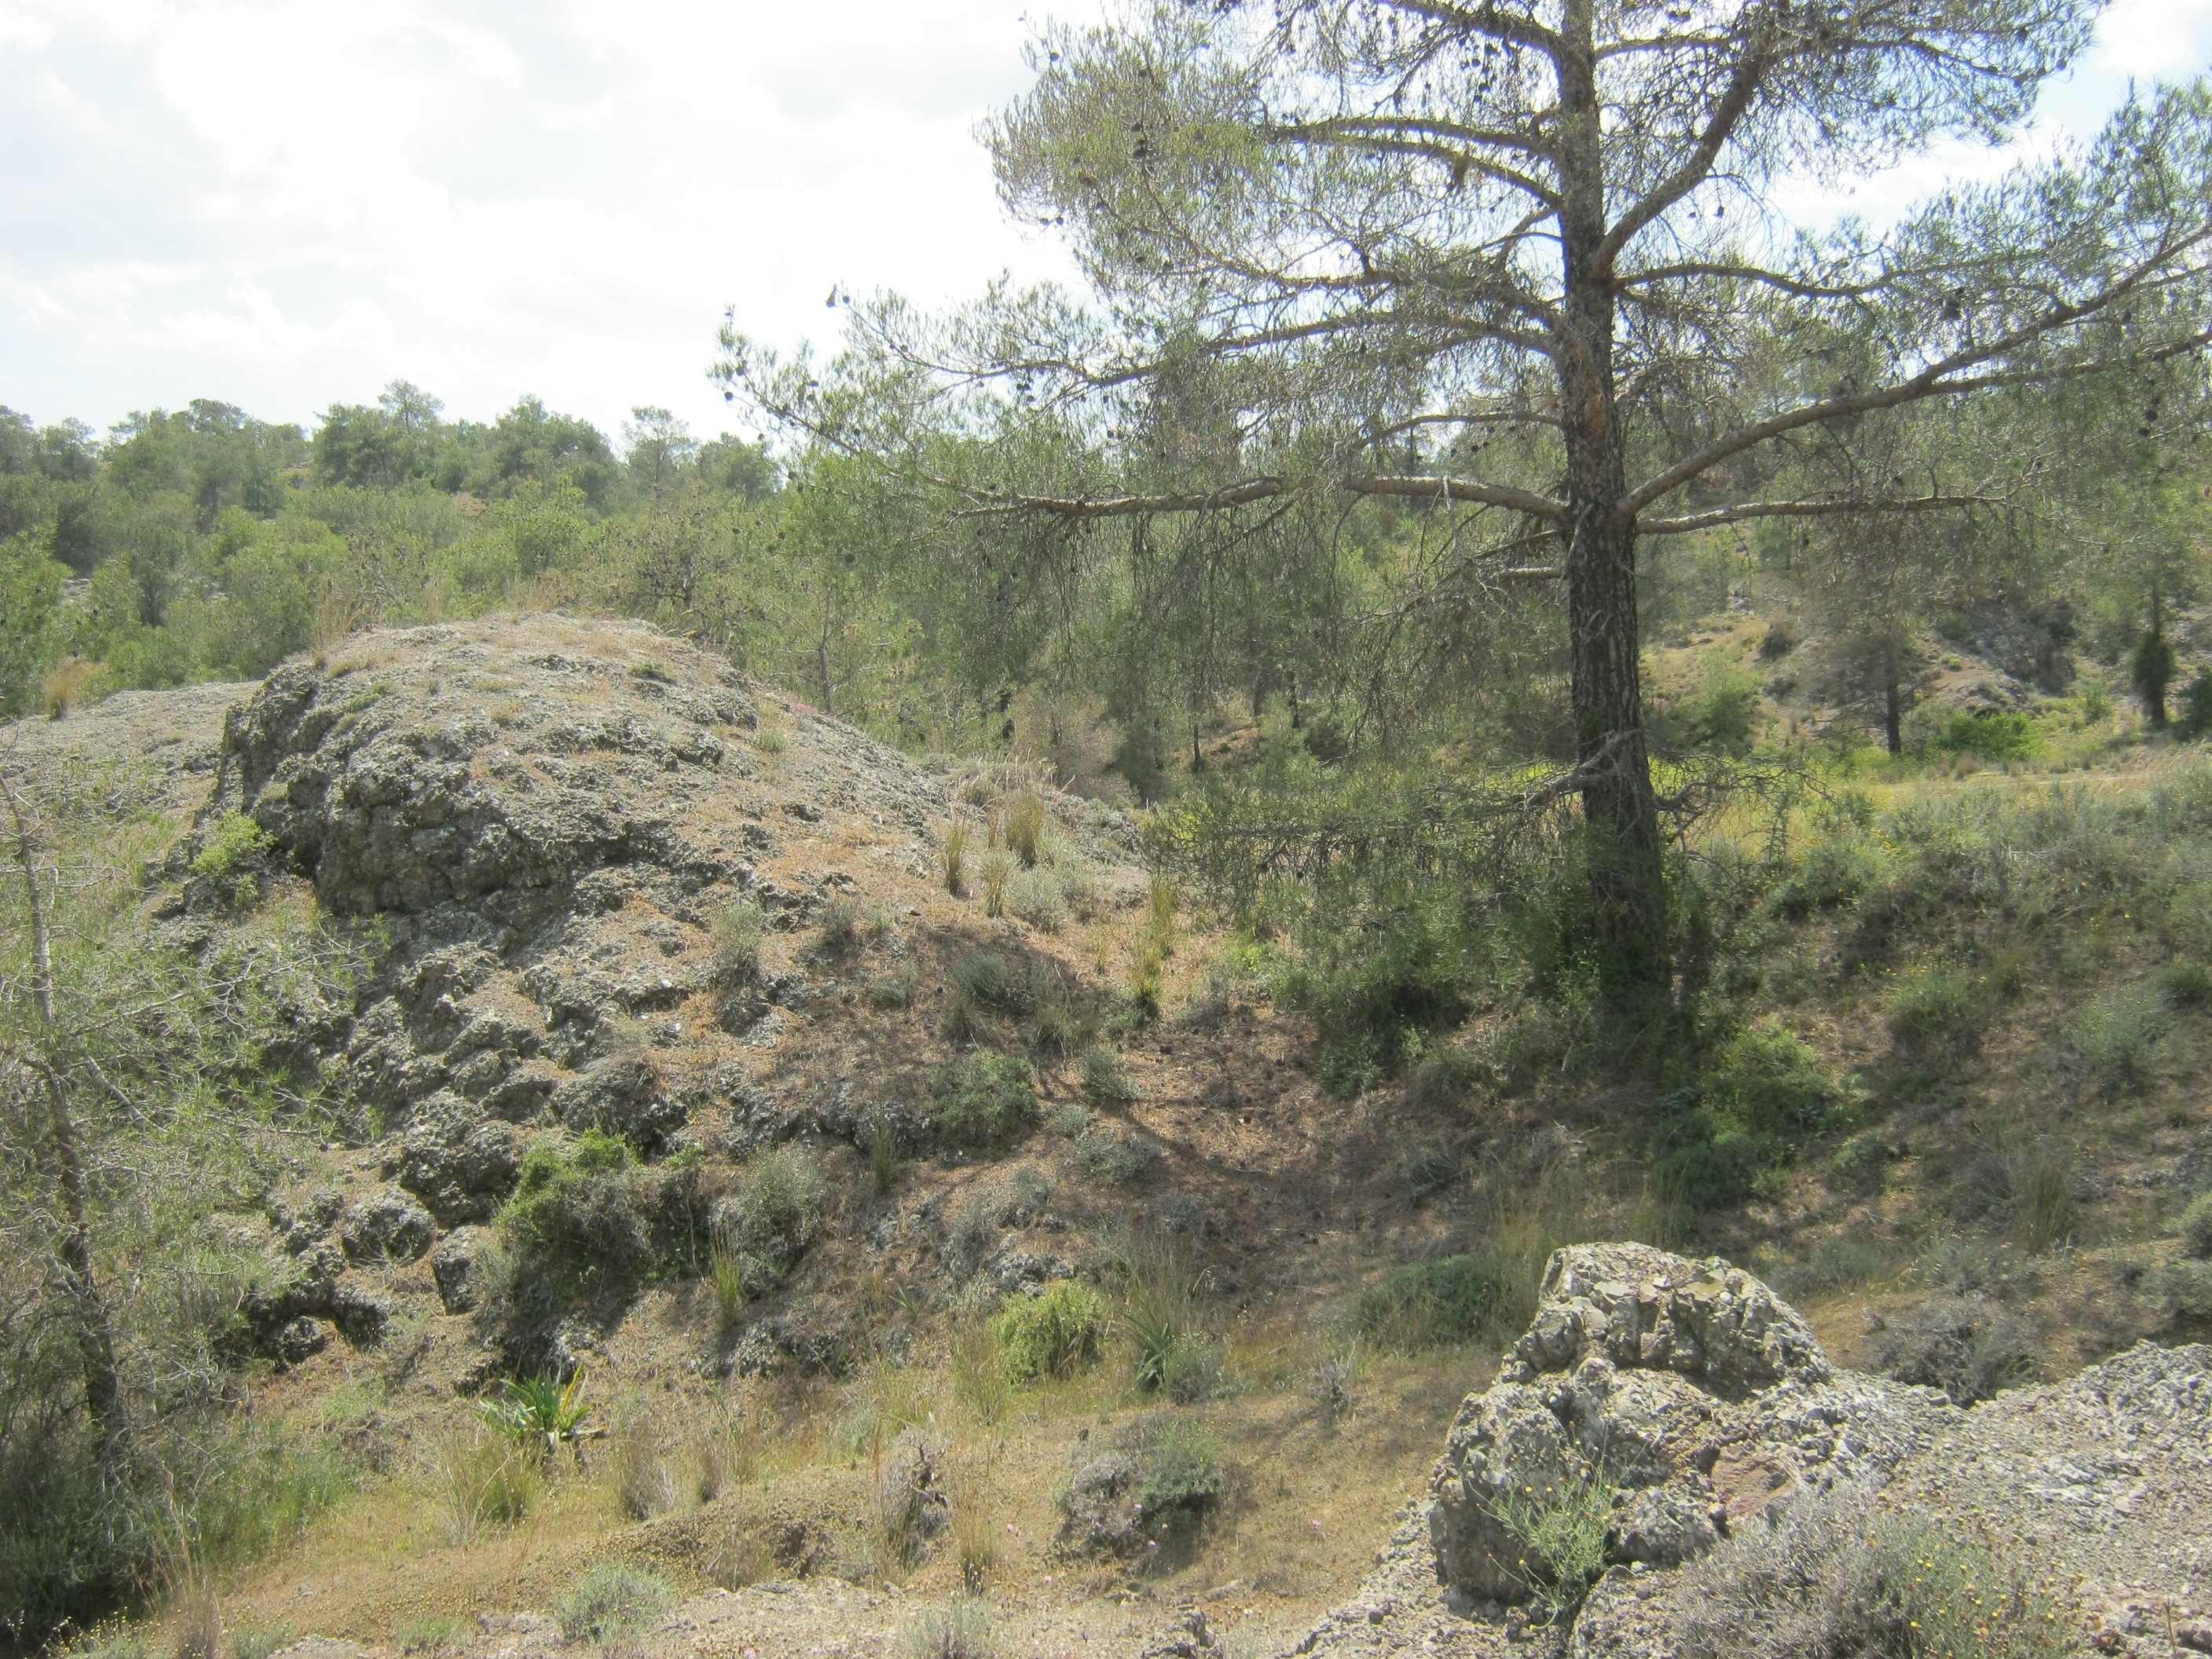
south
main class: Shrubland
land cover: Shrubland with sparse tree cover
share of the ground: 25 - 50 %
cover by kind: herbaceous plants 40 %, shrubs 25 %, unconsolidated bare surface 20 %, consolidated bare surface 10 %, coniferous forest trees 5 %
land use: Forestry
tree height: > 5 m
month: April
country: CY
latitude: 34.9663
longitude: 33.3507
